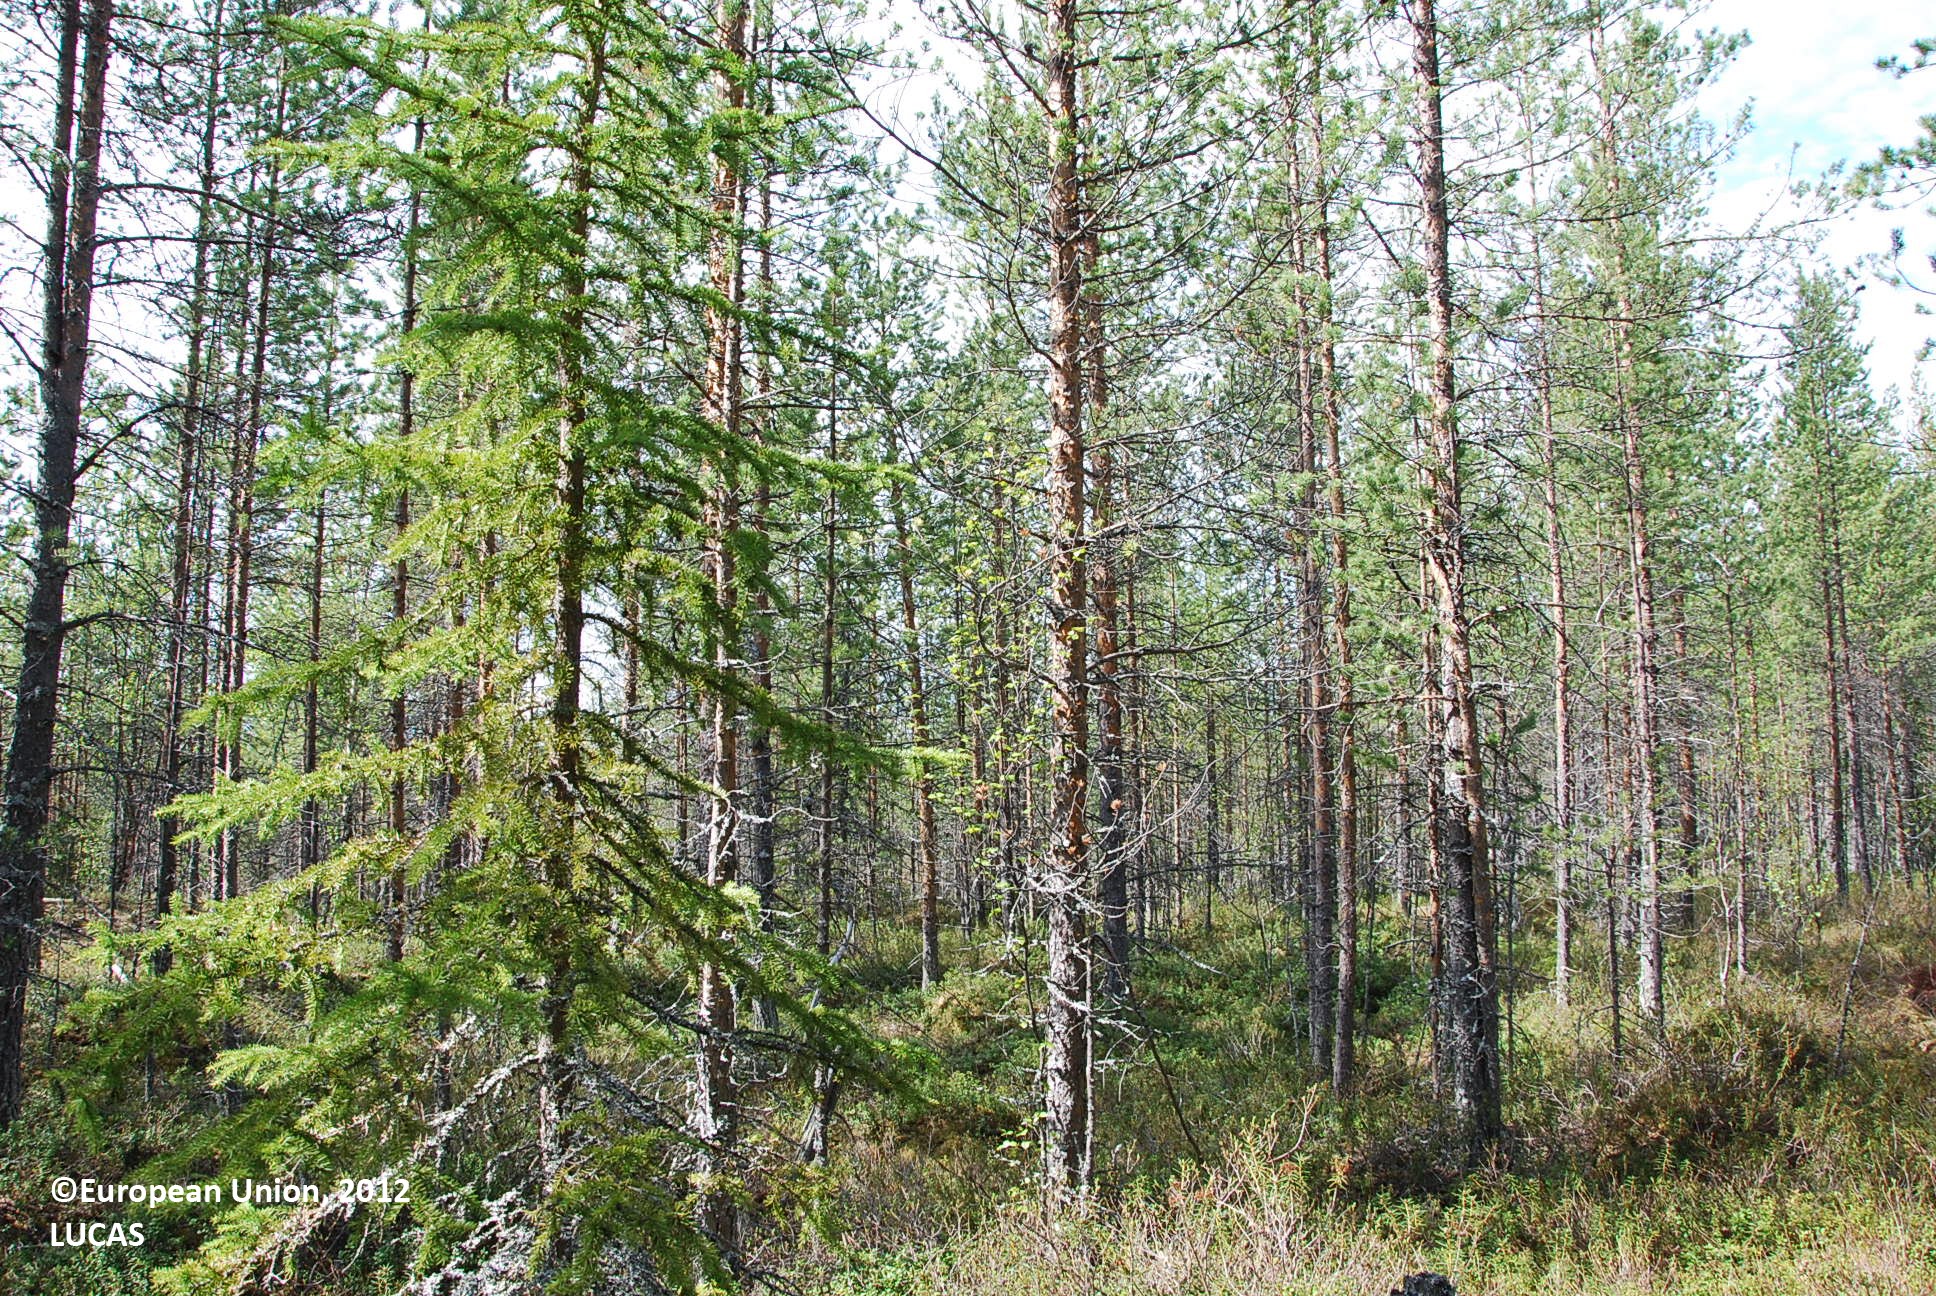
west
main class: Woodland
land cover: Pine dominated coniferous woodland
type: boreal forest
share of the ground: > 75 %
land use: Forestry
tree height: > 5 m
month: June
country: FI
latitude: 66.6011
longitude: 28.0230
